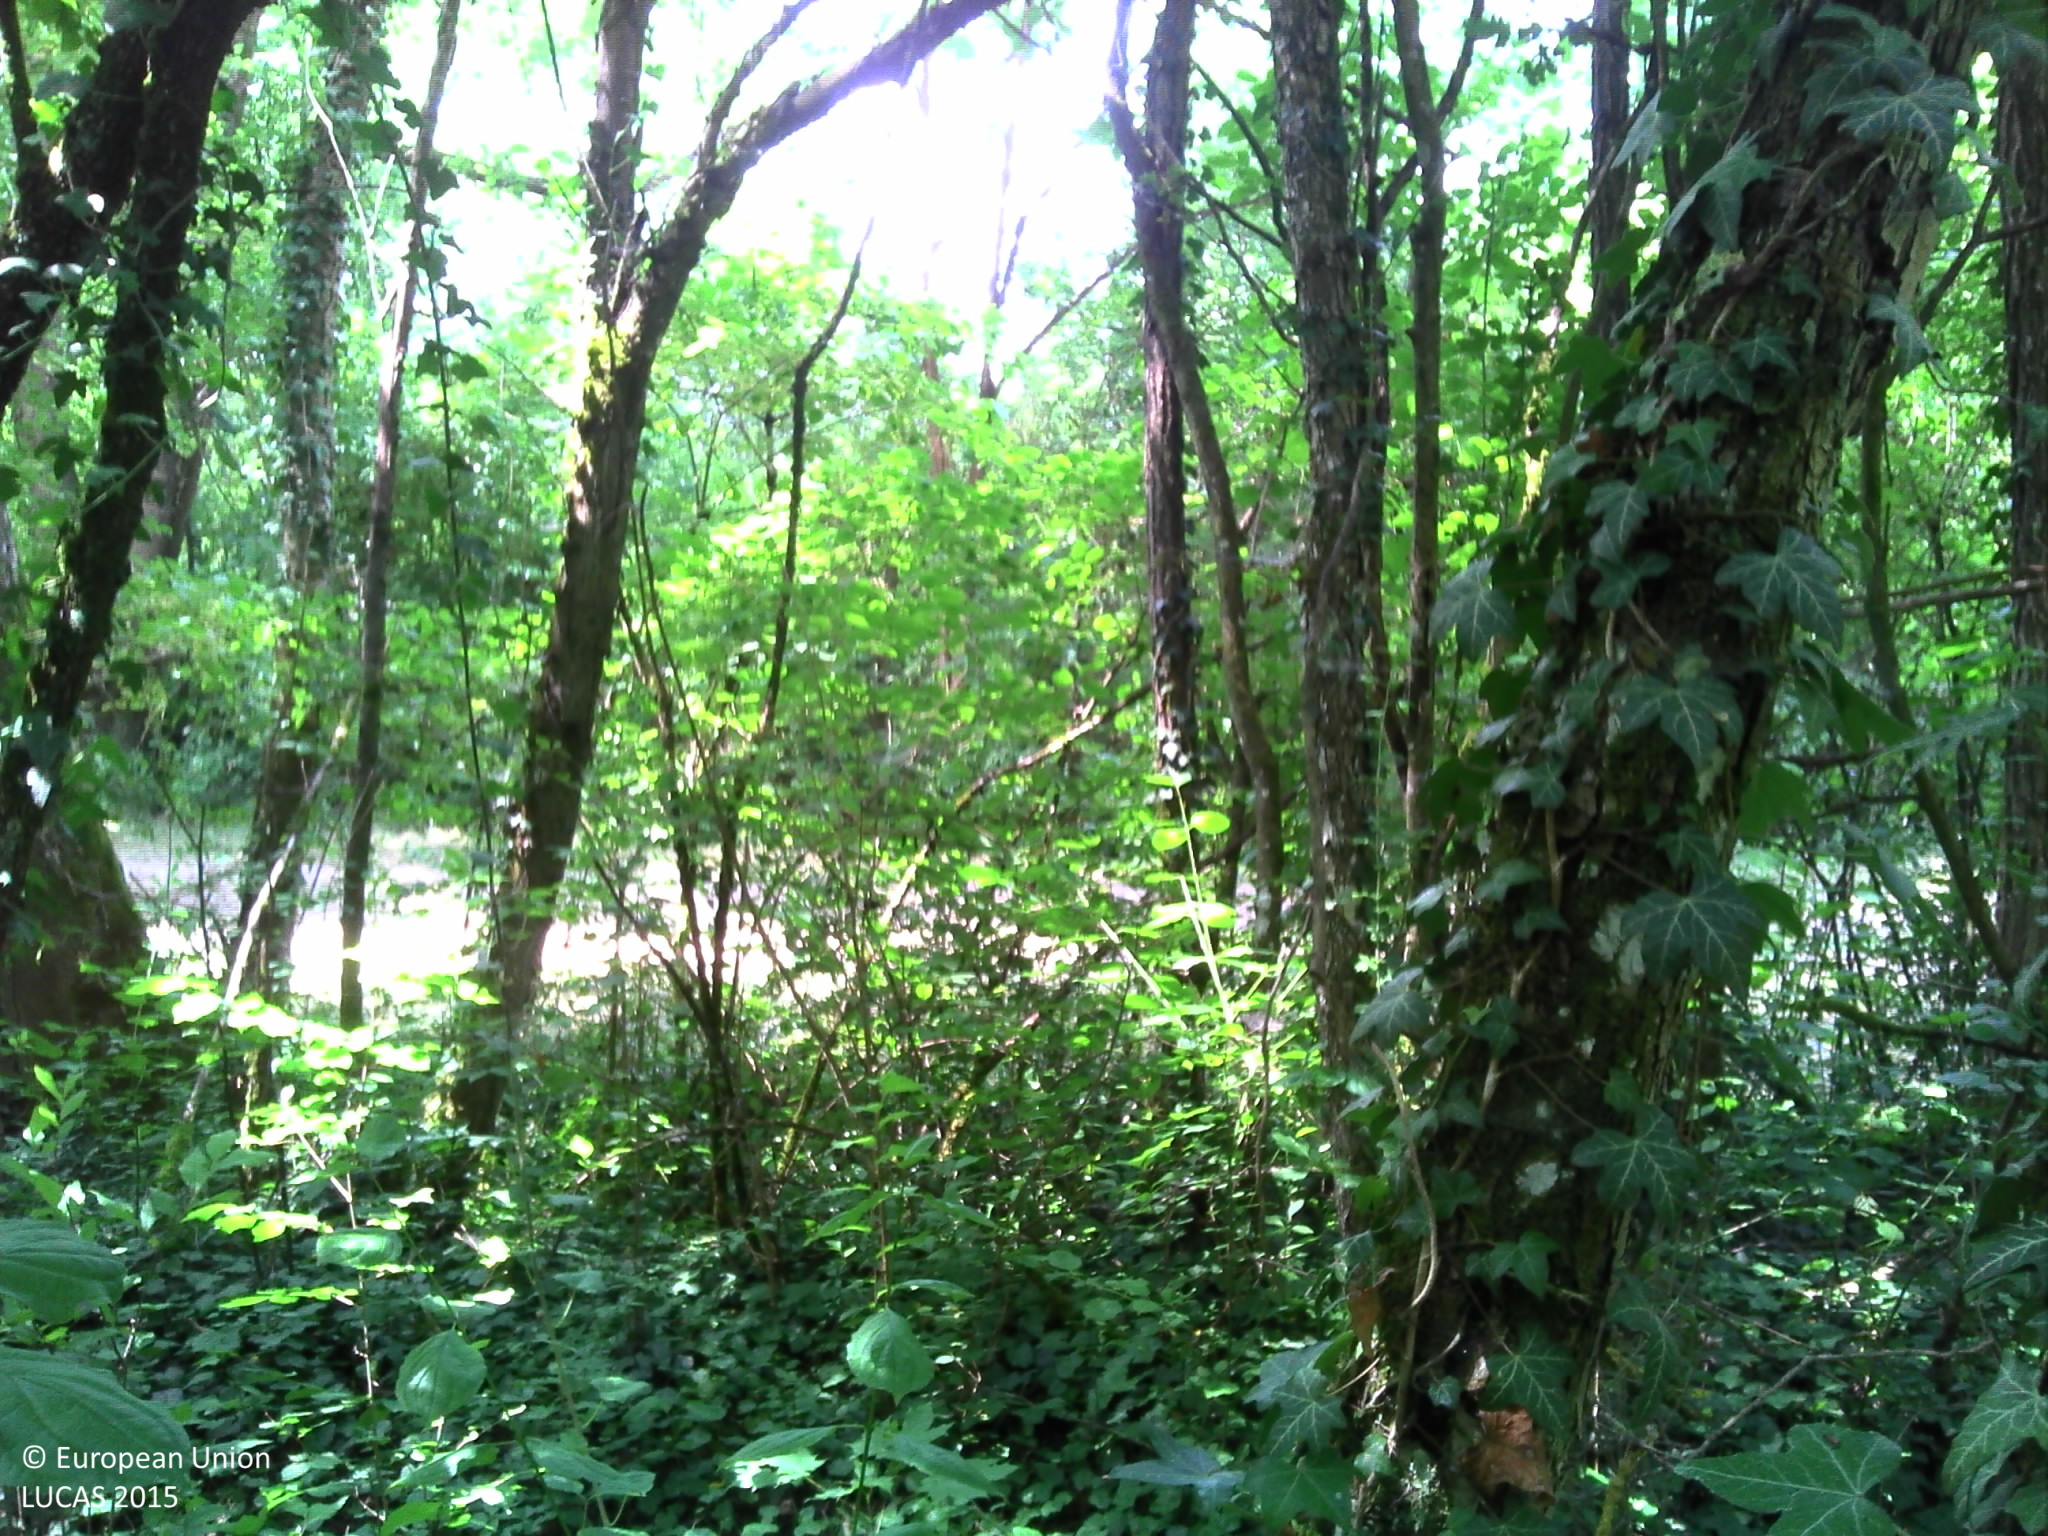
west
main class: Woodland
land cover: Broadleaved woodland
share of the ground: > 75 %
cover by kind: broadleaved forest trees 90 %, herbaceous plants 5 %, lichens and mosses 5 %
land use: Semi-natural and natural areas not in use
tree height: < 5 m
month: July
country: FR
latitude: 48.6712
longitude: 5.9395
